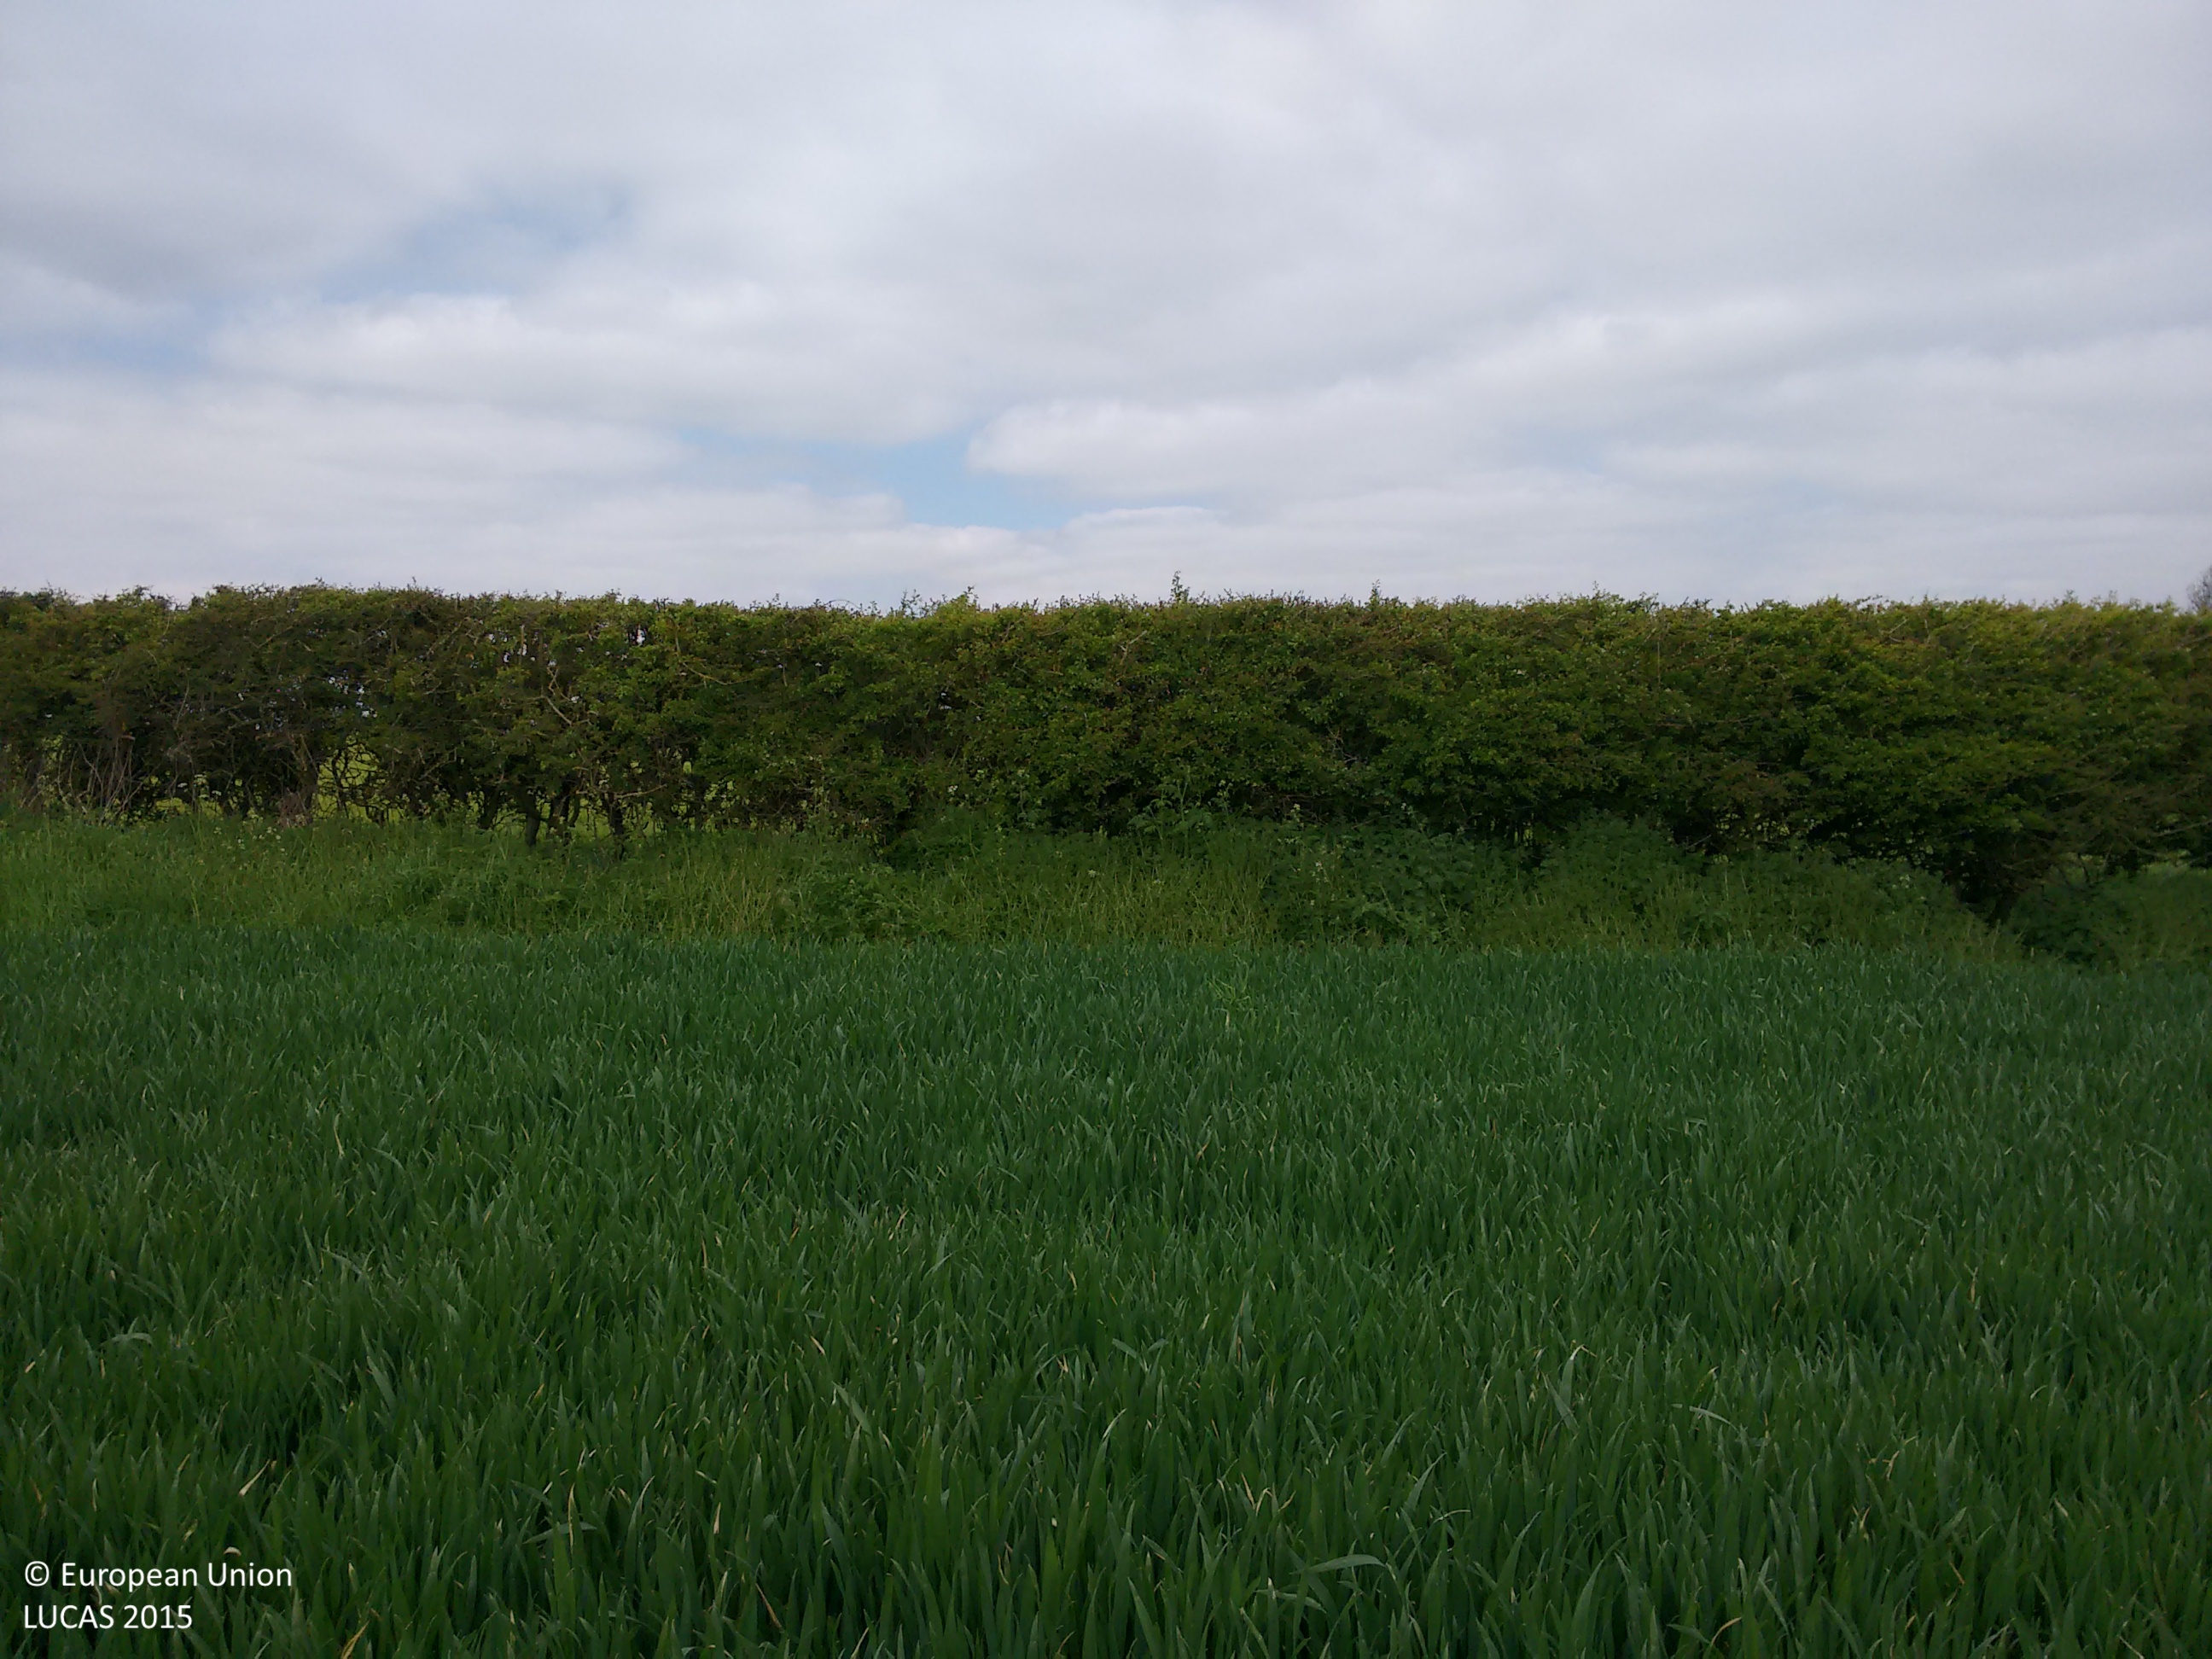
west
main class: Cropland
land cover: Common wheat
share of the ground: > 75 %
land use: Agriculture (excluding fallow land and kitchen gardens)
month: May
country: GB
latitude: 53.7283
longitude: -0.0201
